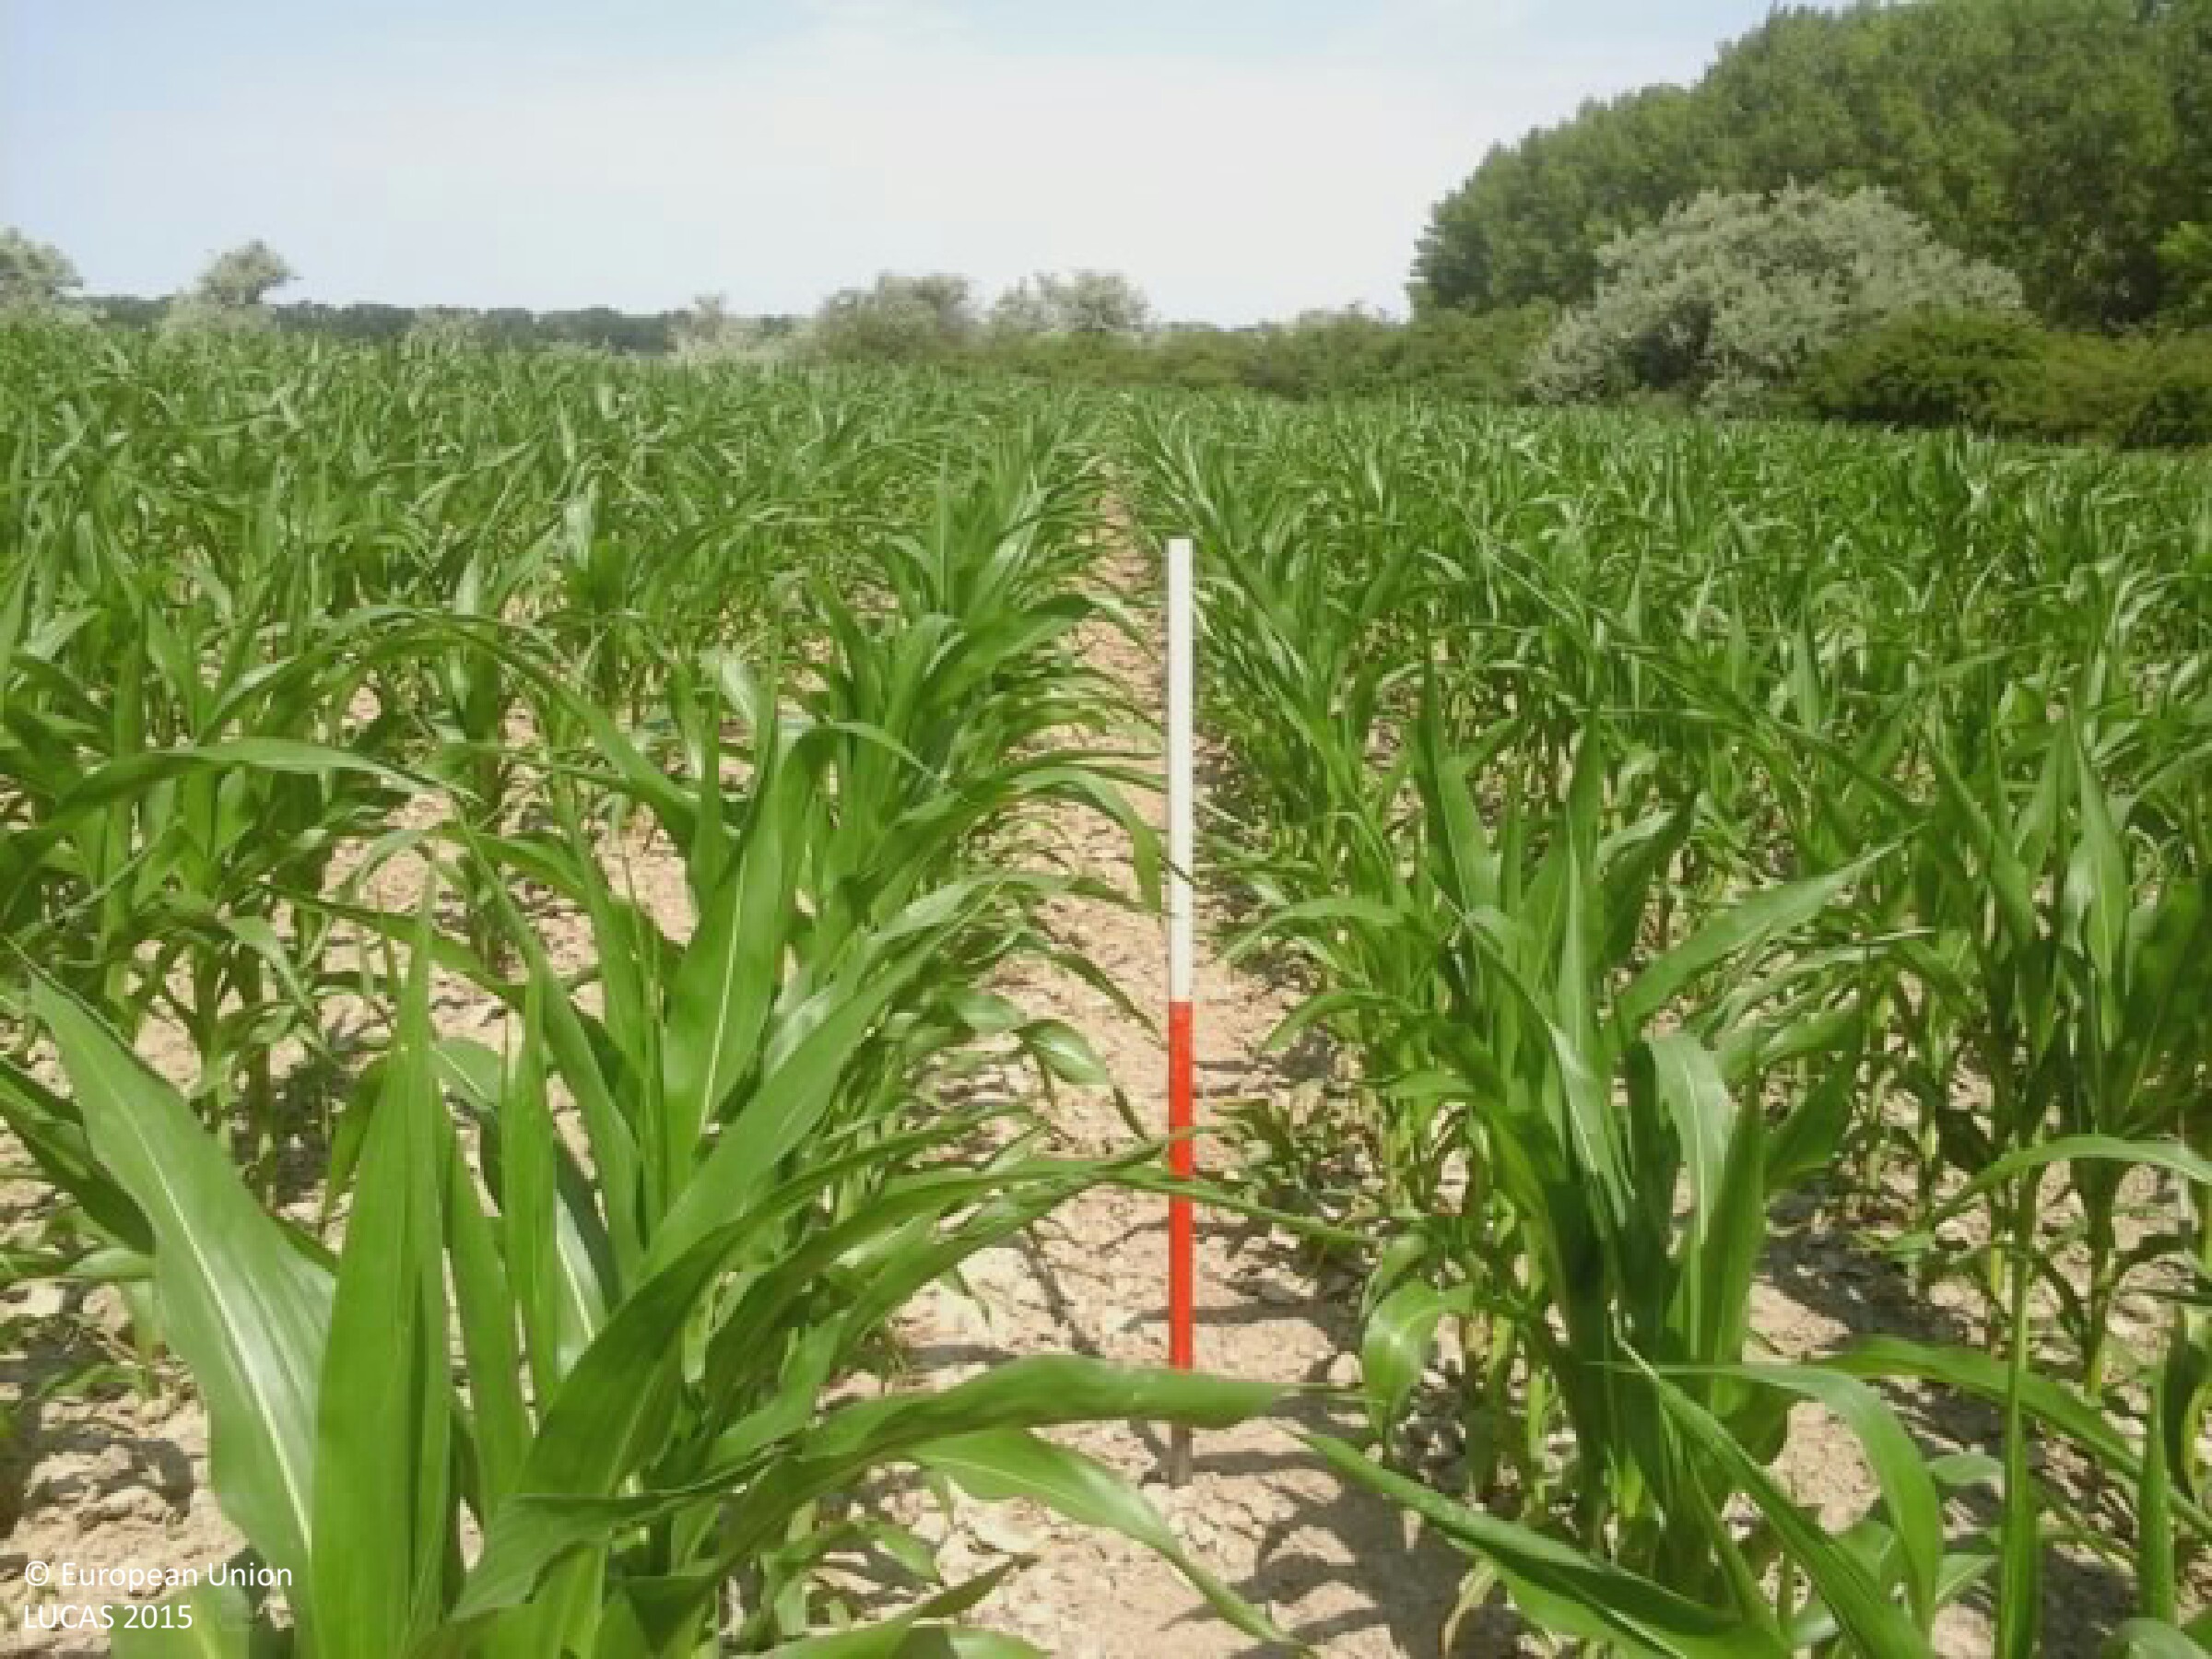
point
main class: Cropland
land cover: Maize
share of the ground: 50 - 75 %
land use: Agriculture (excluding fallow land and kitchen gardens)
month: July
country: HU
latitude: 46.7046
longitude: 18.8946
